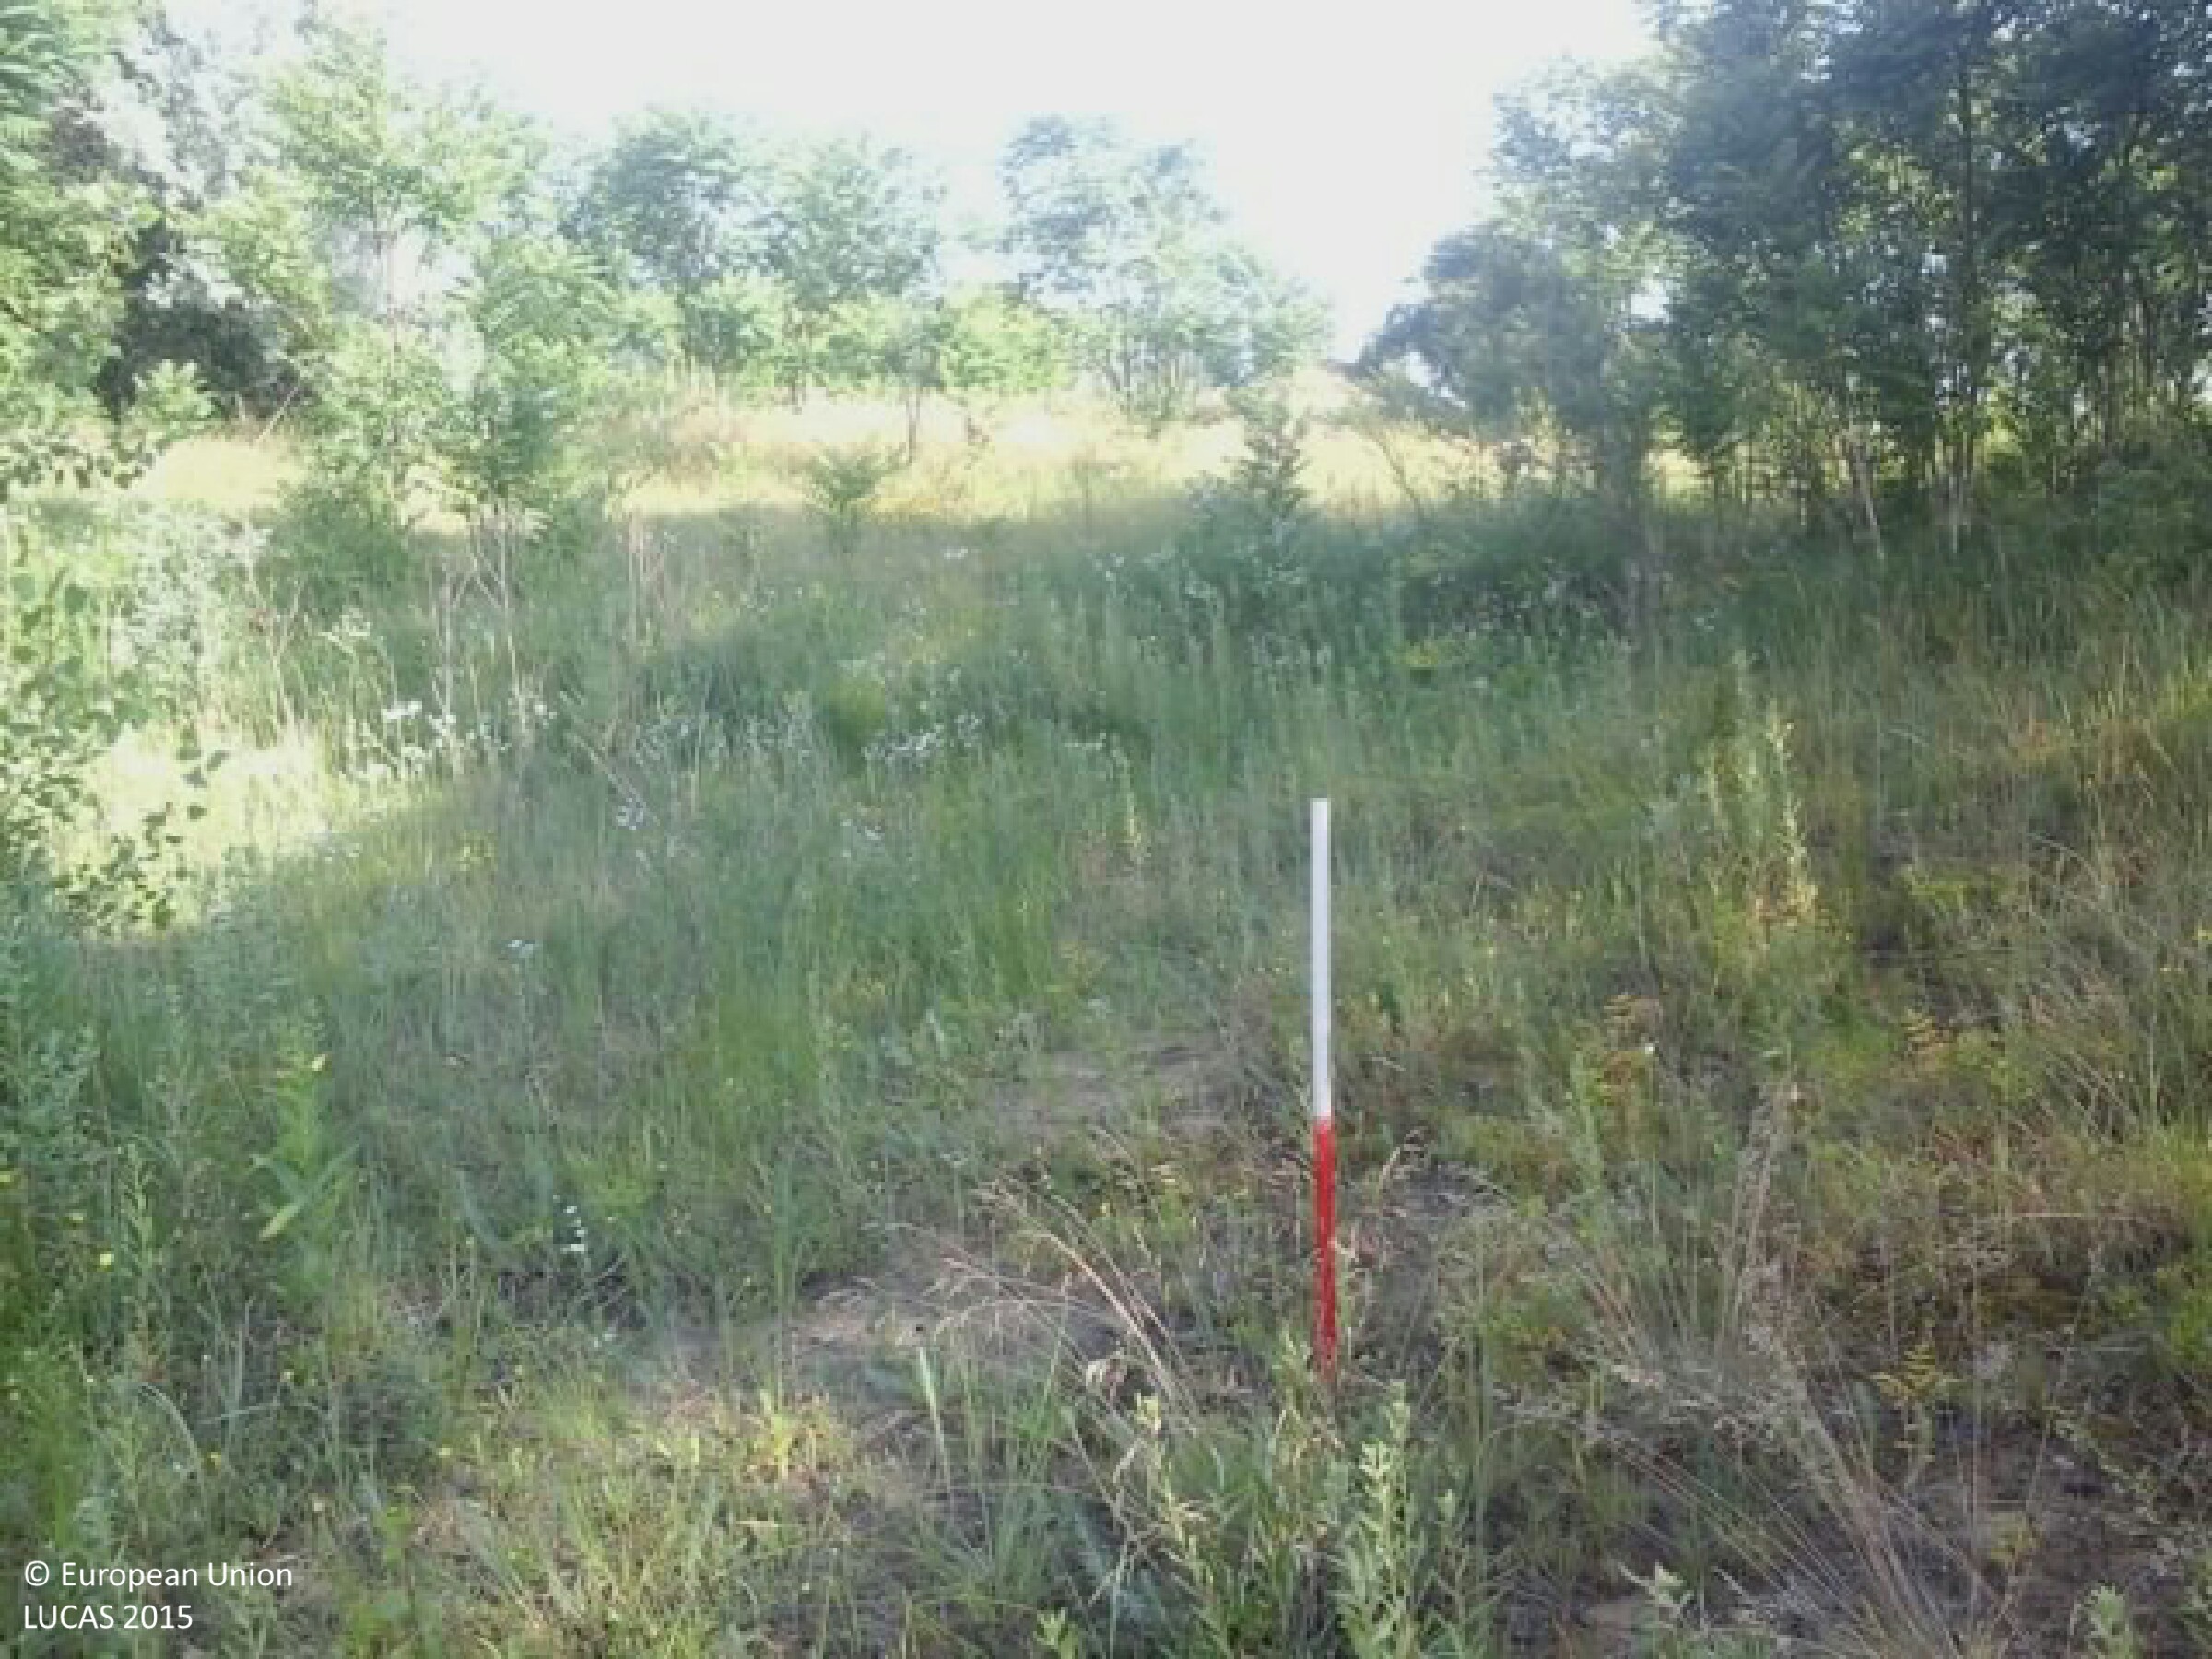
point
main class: Grassland
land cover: Grassland with sparse tree/shrub cover
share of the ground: > 75 %
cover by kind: herbaceous plants 85 %, shrubs 10 %, broadleaved forest trees 5 %
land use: Semi-natural and natural areas not in use
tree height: < 5 m
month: June
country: HU
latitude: 46.1893
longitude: 18.9913
